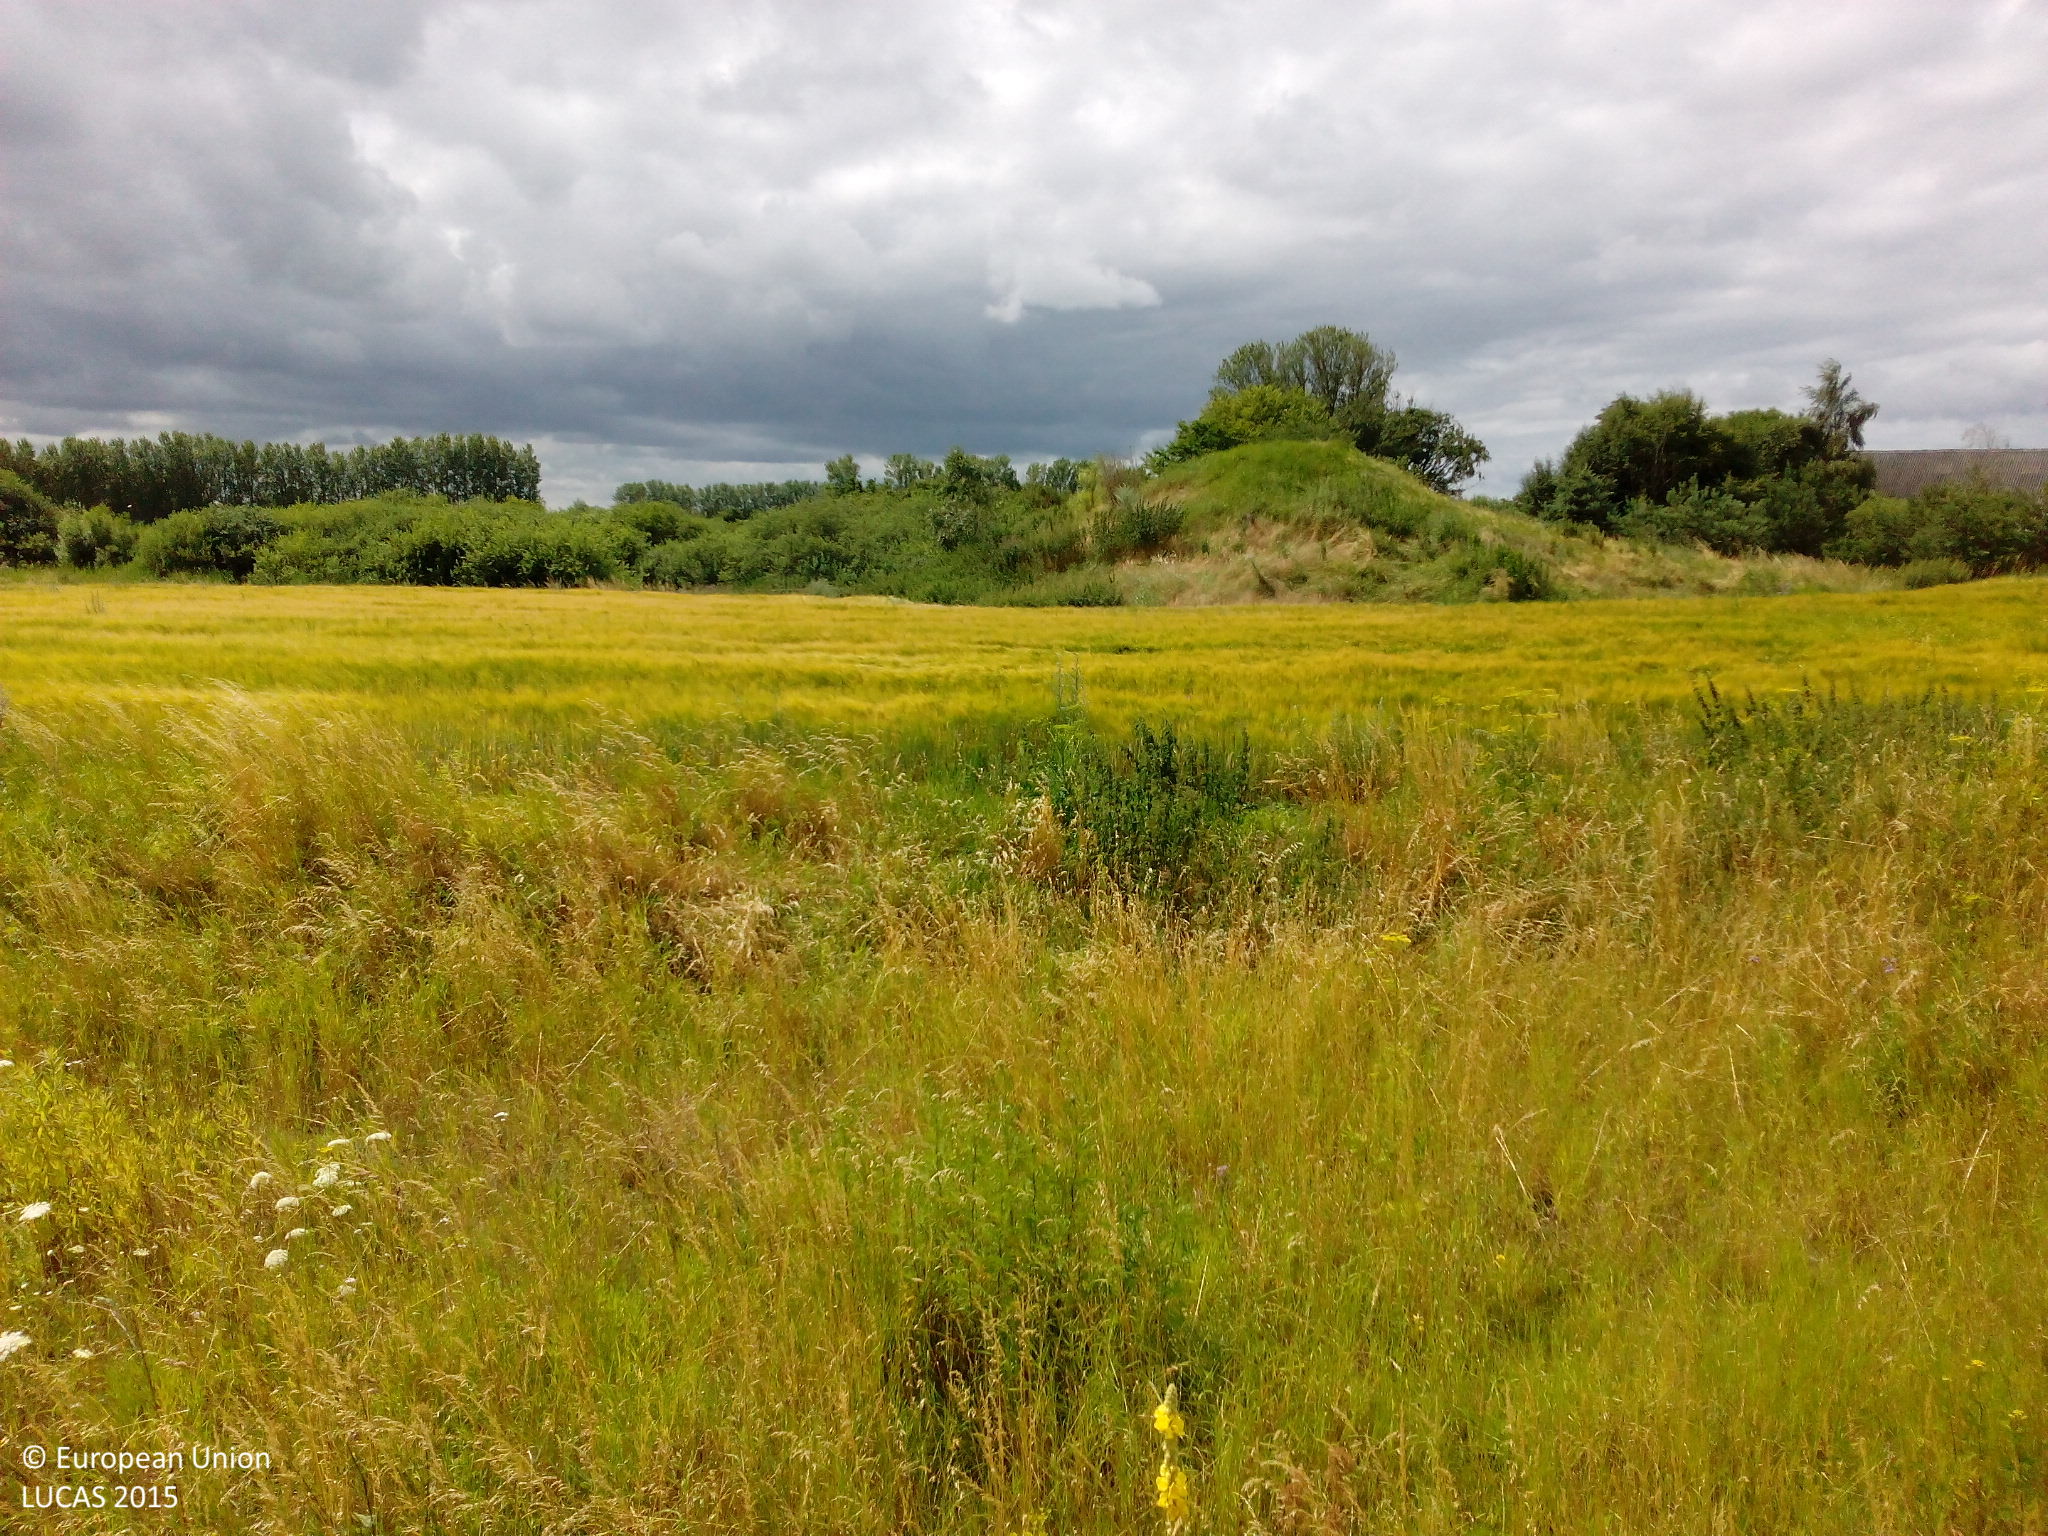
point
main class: Woodland
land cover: Broadleaved woodland
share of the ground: > 75 %
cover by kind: broadleaved forest trees 80 %, herbaceous plants 20 %
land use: Semi-natural and natural areas not in use
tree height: > 5 m
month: July
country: DK
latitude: 55.9527
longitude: 12.2240
